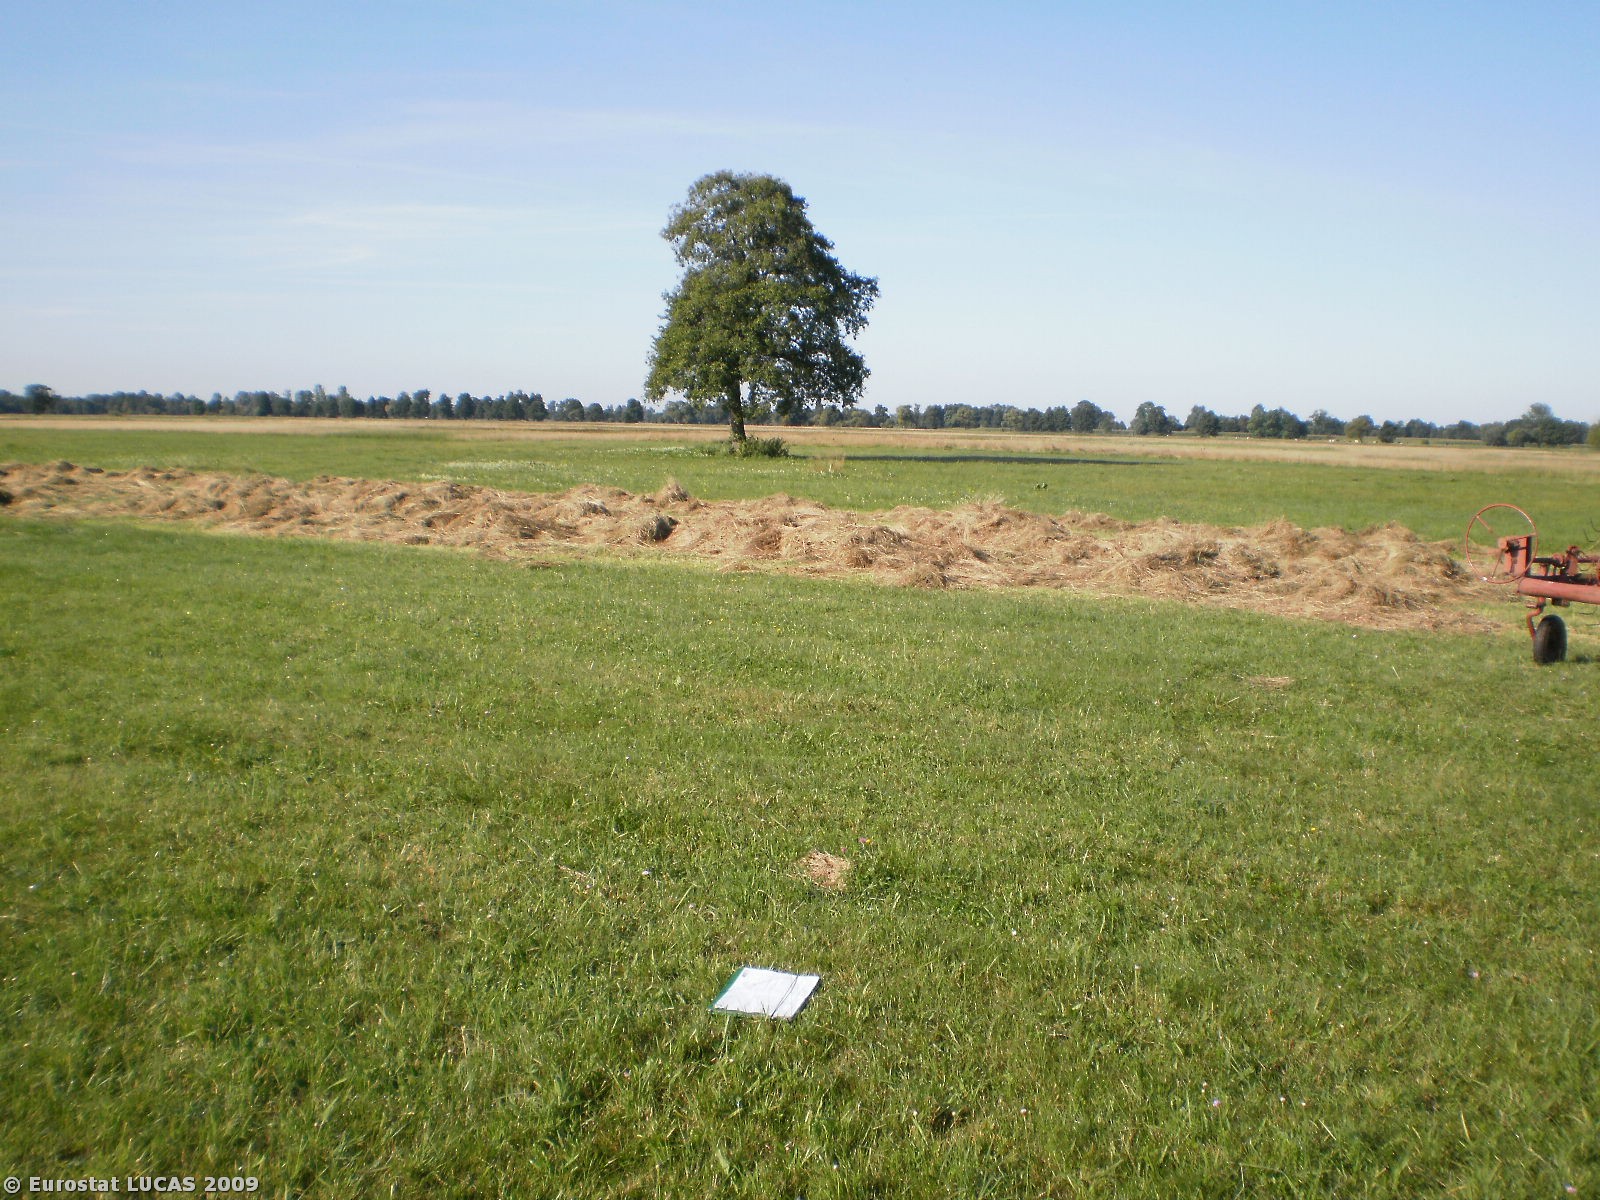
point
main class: Grassland
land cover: Grassland without tree/shrub cover
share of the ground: > 75 %
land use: Agriculture (excluding fallow land and kitchen gardens)
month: August
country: PL
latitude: 52.6611
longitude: 21.7793
